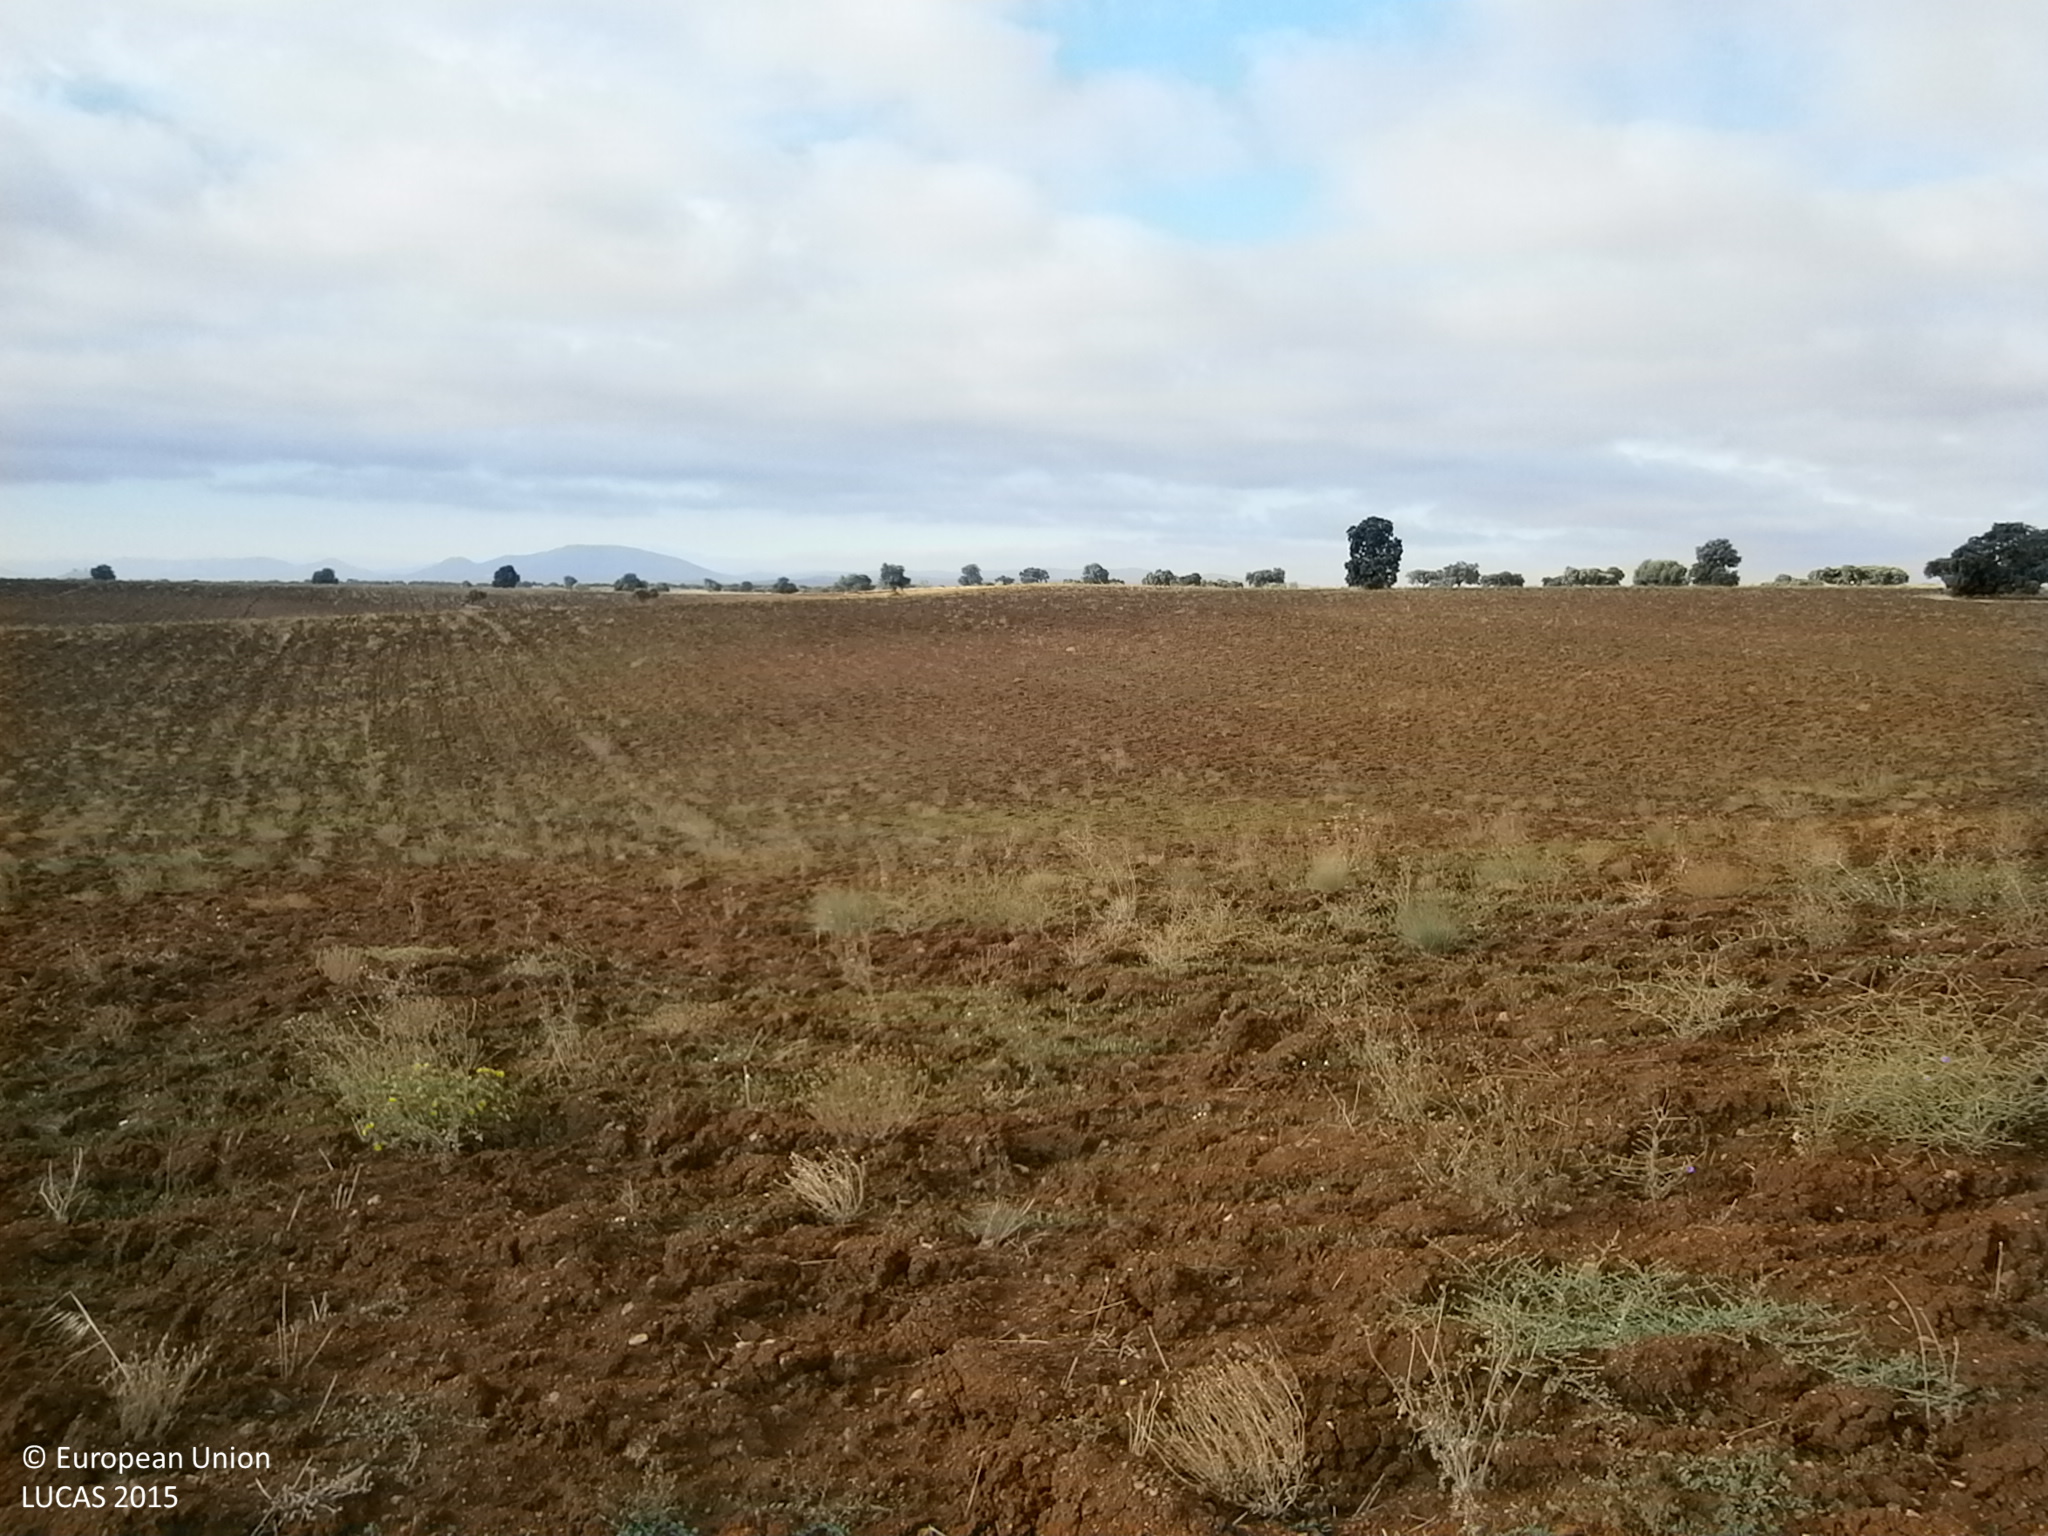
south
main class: Grassland
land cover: Spontaneously vegetated surfaces
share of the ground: > 75 %
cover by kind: herbaceous plants 75 %, unconsolidated bare surface 25 %
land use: Fallow land
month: June
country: ES
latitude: 38.6760
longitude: -6.8101
